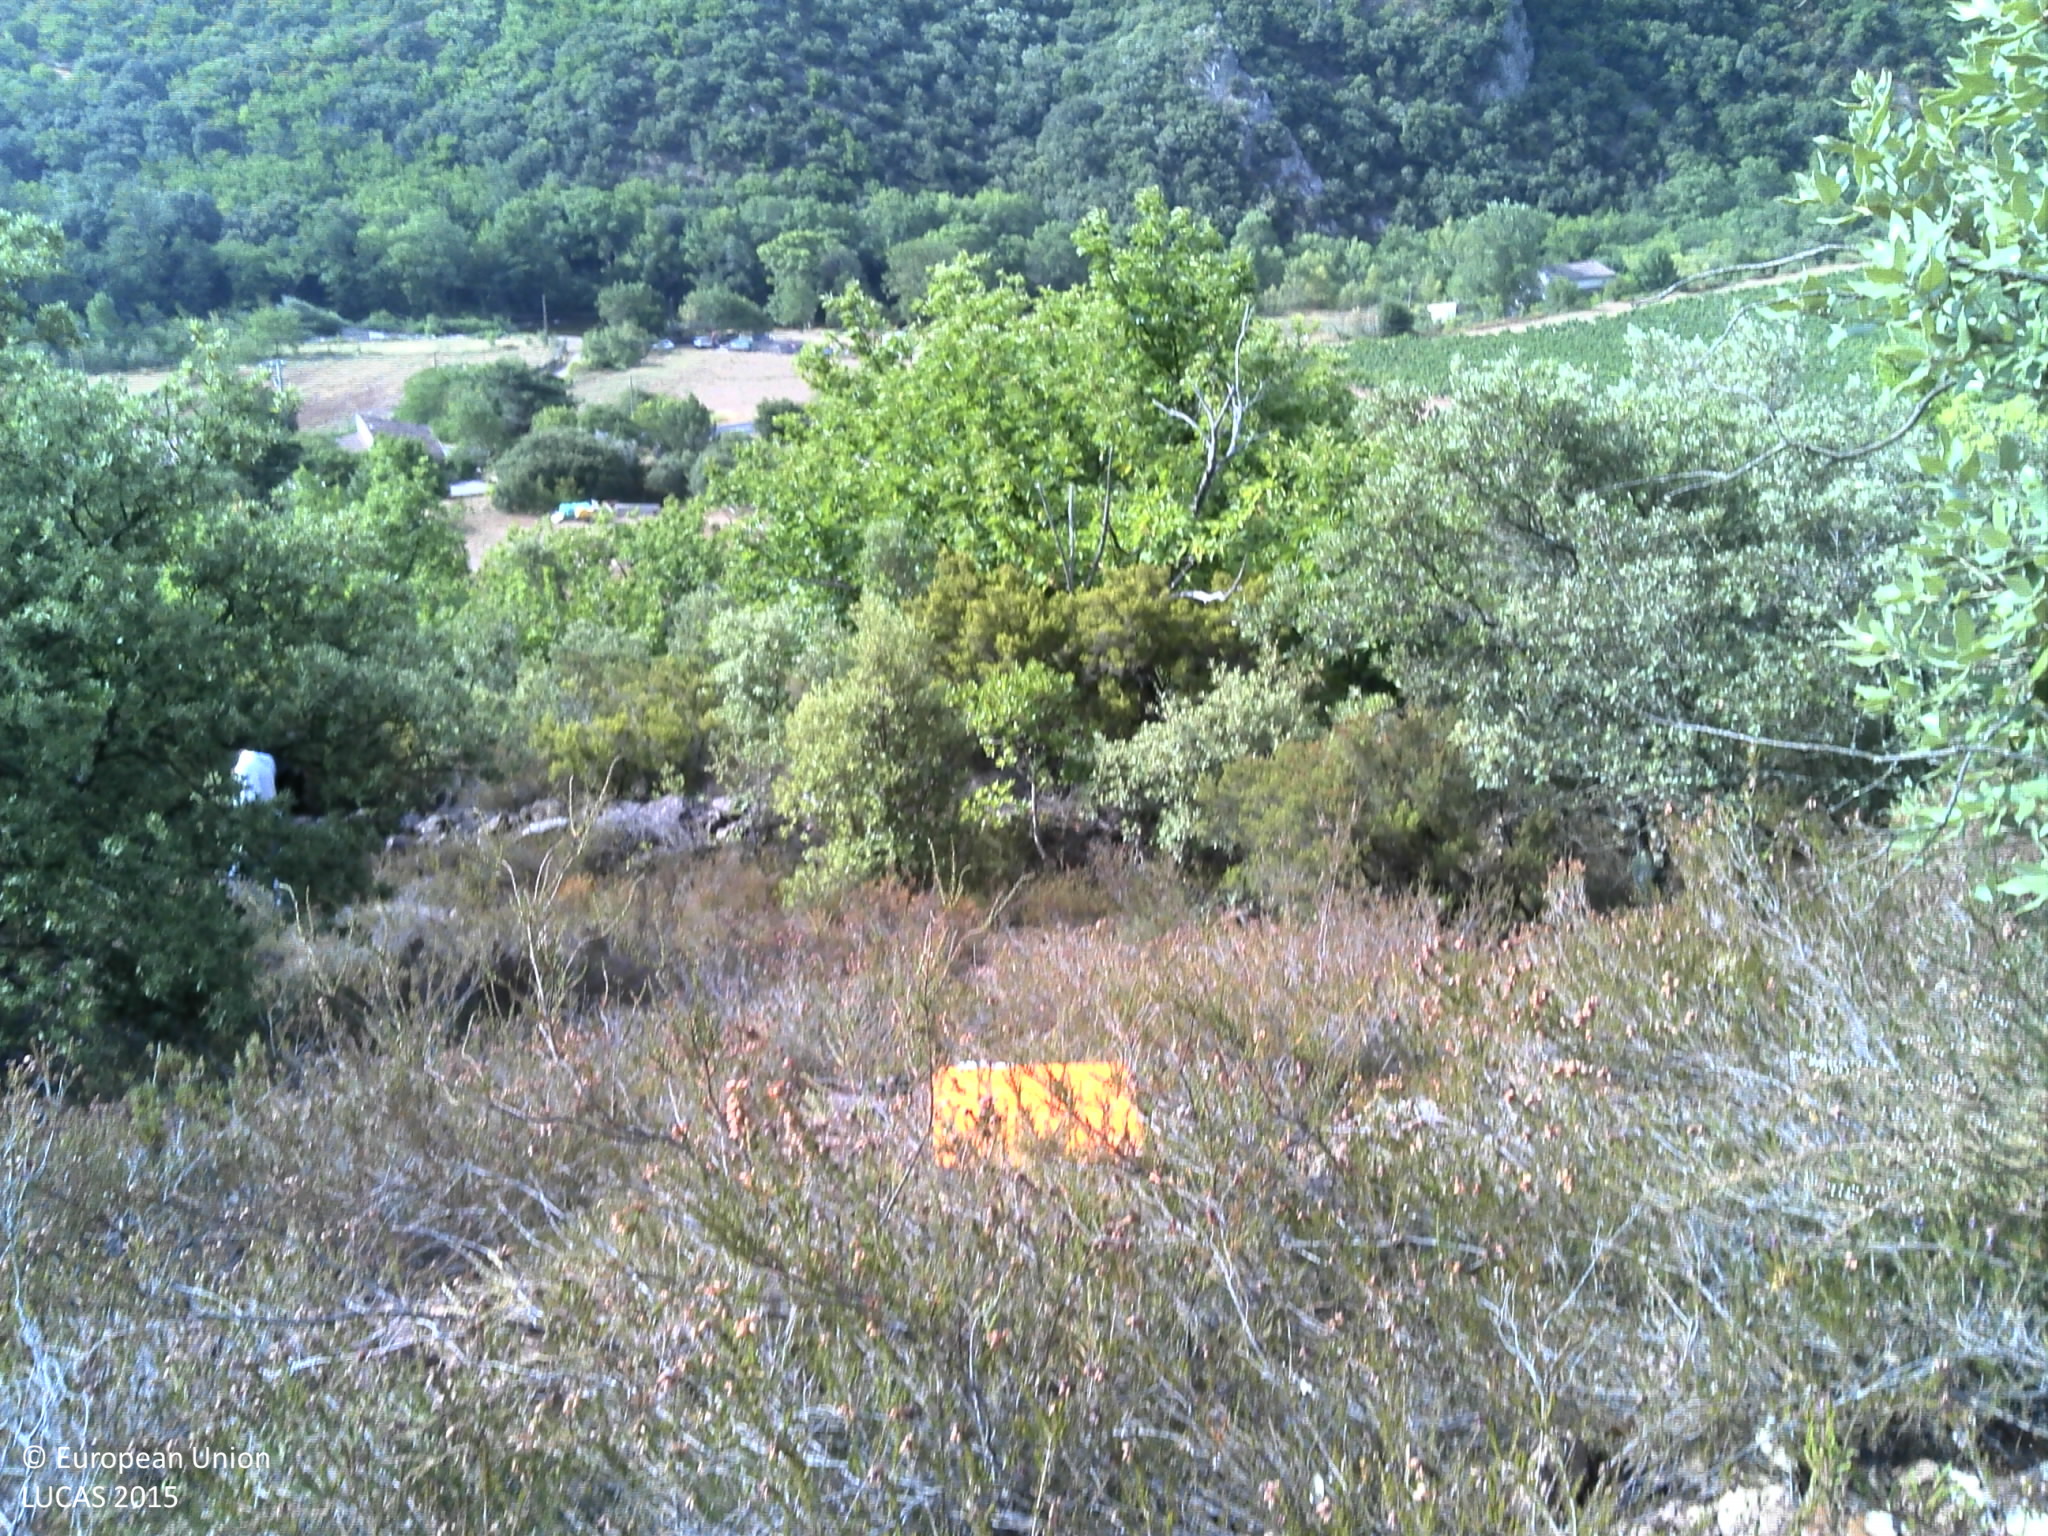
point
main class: Shrubland
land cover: Shrubland with sparse tree cover
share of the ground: > 75 %
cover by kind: shrubs 70 %, consolidated bare surface 25 %, broadleaved forest trees 5 %
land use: Semi-natural and natural areas not in use
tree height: < 5 m
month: July
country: FR
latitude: 43.7254
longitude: 3.1428
